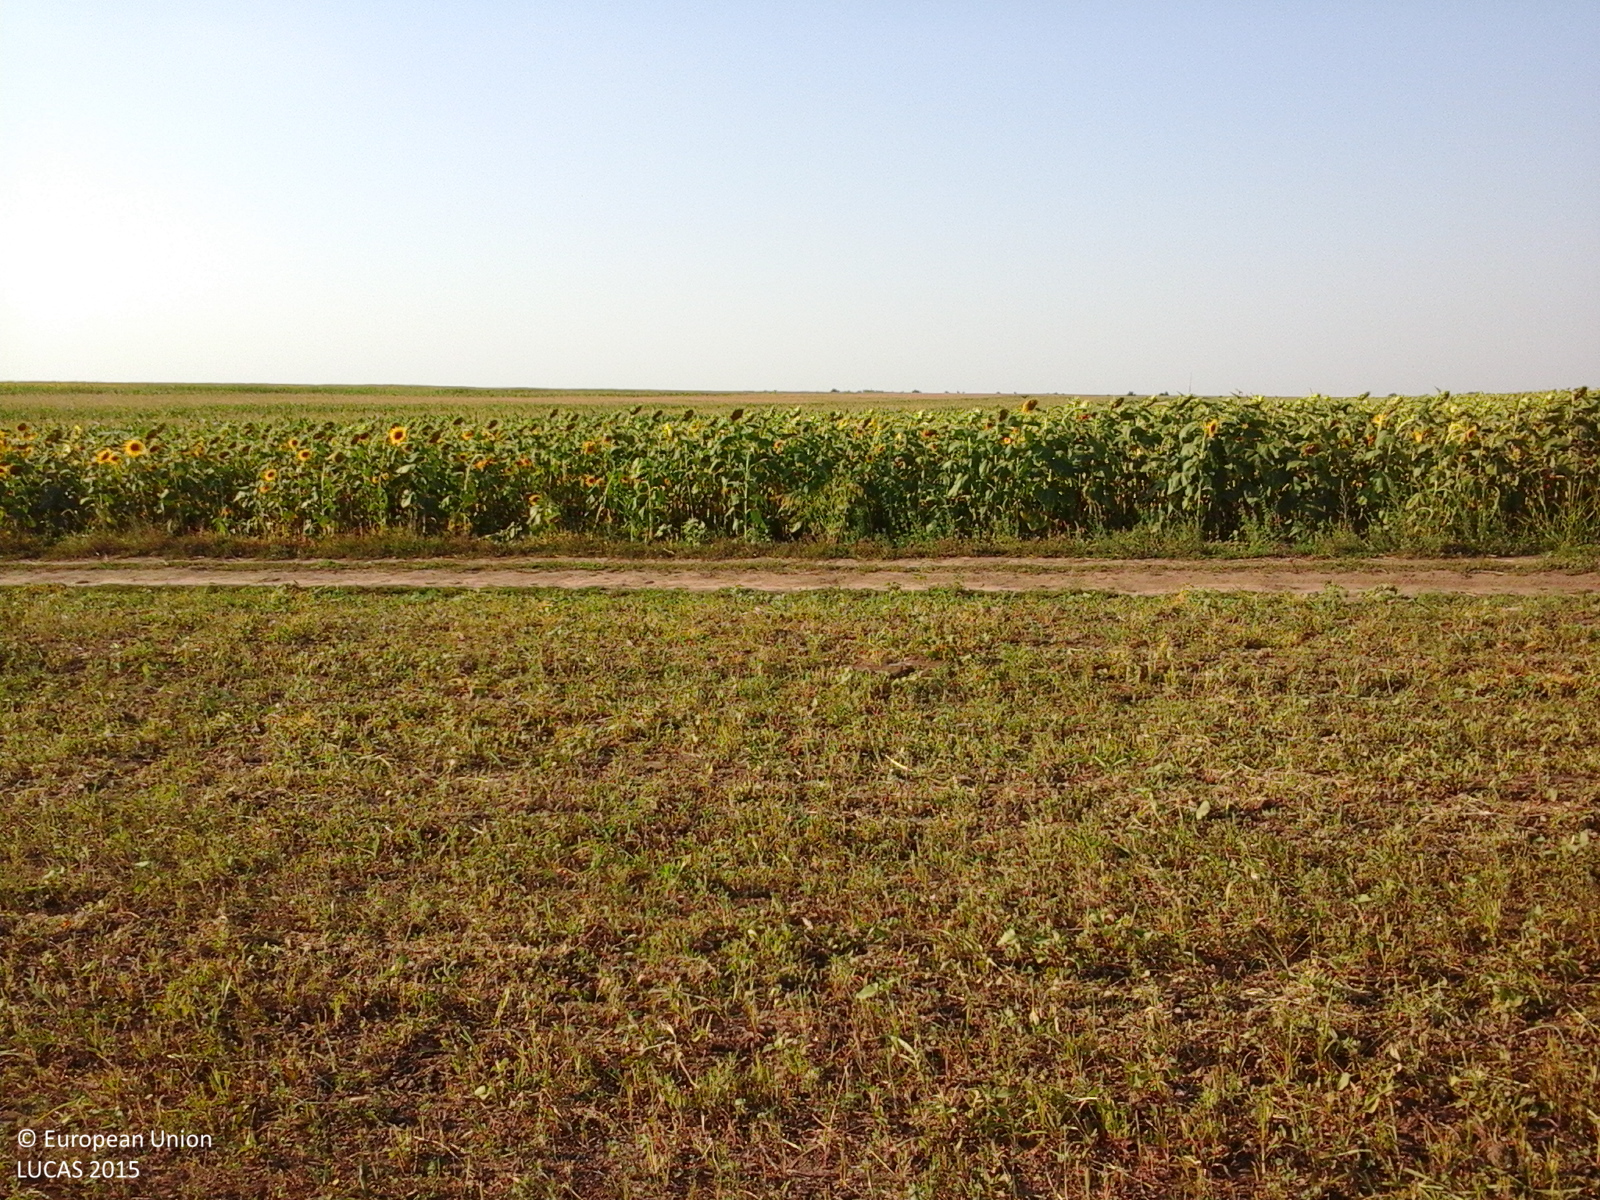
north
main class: Cropland
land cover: Lucerne
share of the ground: > 75 %
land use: Agriculture (excluding fallow land and kitchen gardens)
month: July
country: RO
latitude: 44.8120
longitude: 27.2212
